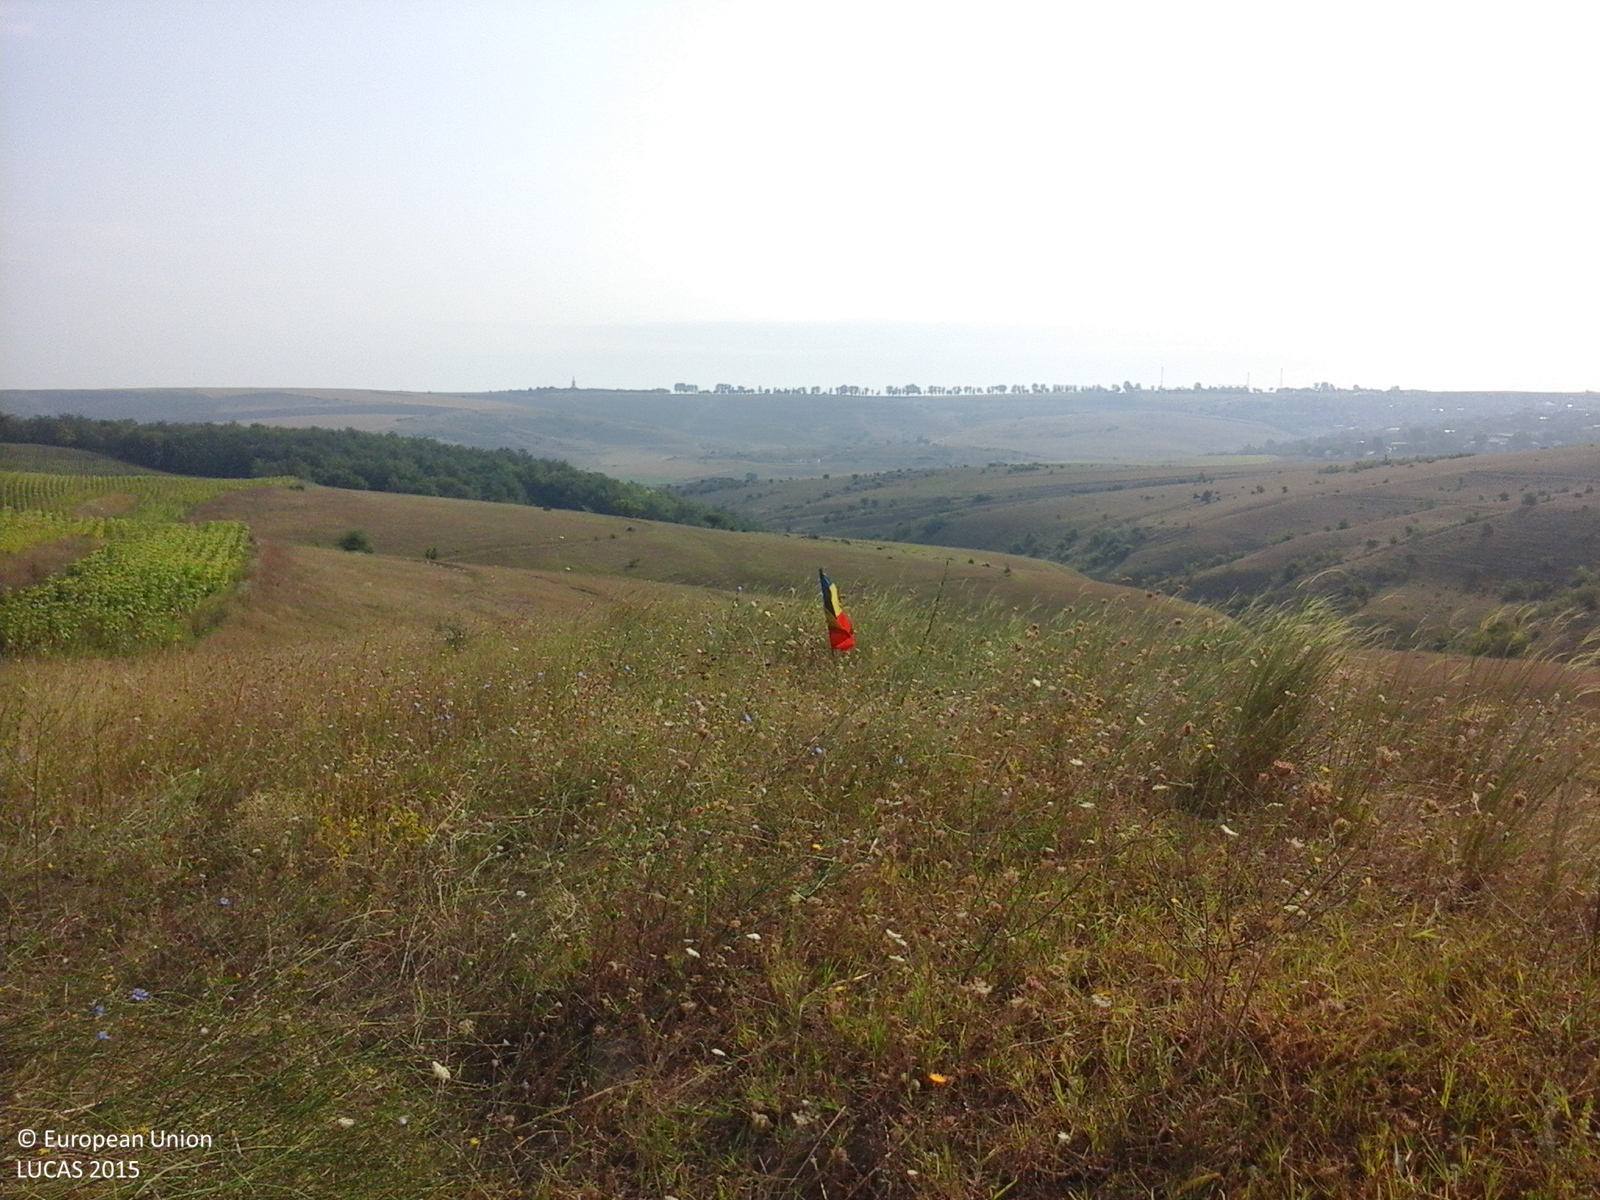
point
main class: Grassland
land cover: Grassland without tree/shrub cover
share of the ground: > 75 %
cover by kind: herbaceous plants 100 %
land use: Agriculture (excluding fallow land and kitchen gardens)
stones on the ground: < 10 %
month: August
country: RO
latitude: 44.0839
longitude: 27.9217
